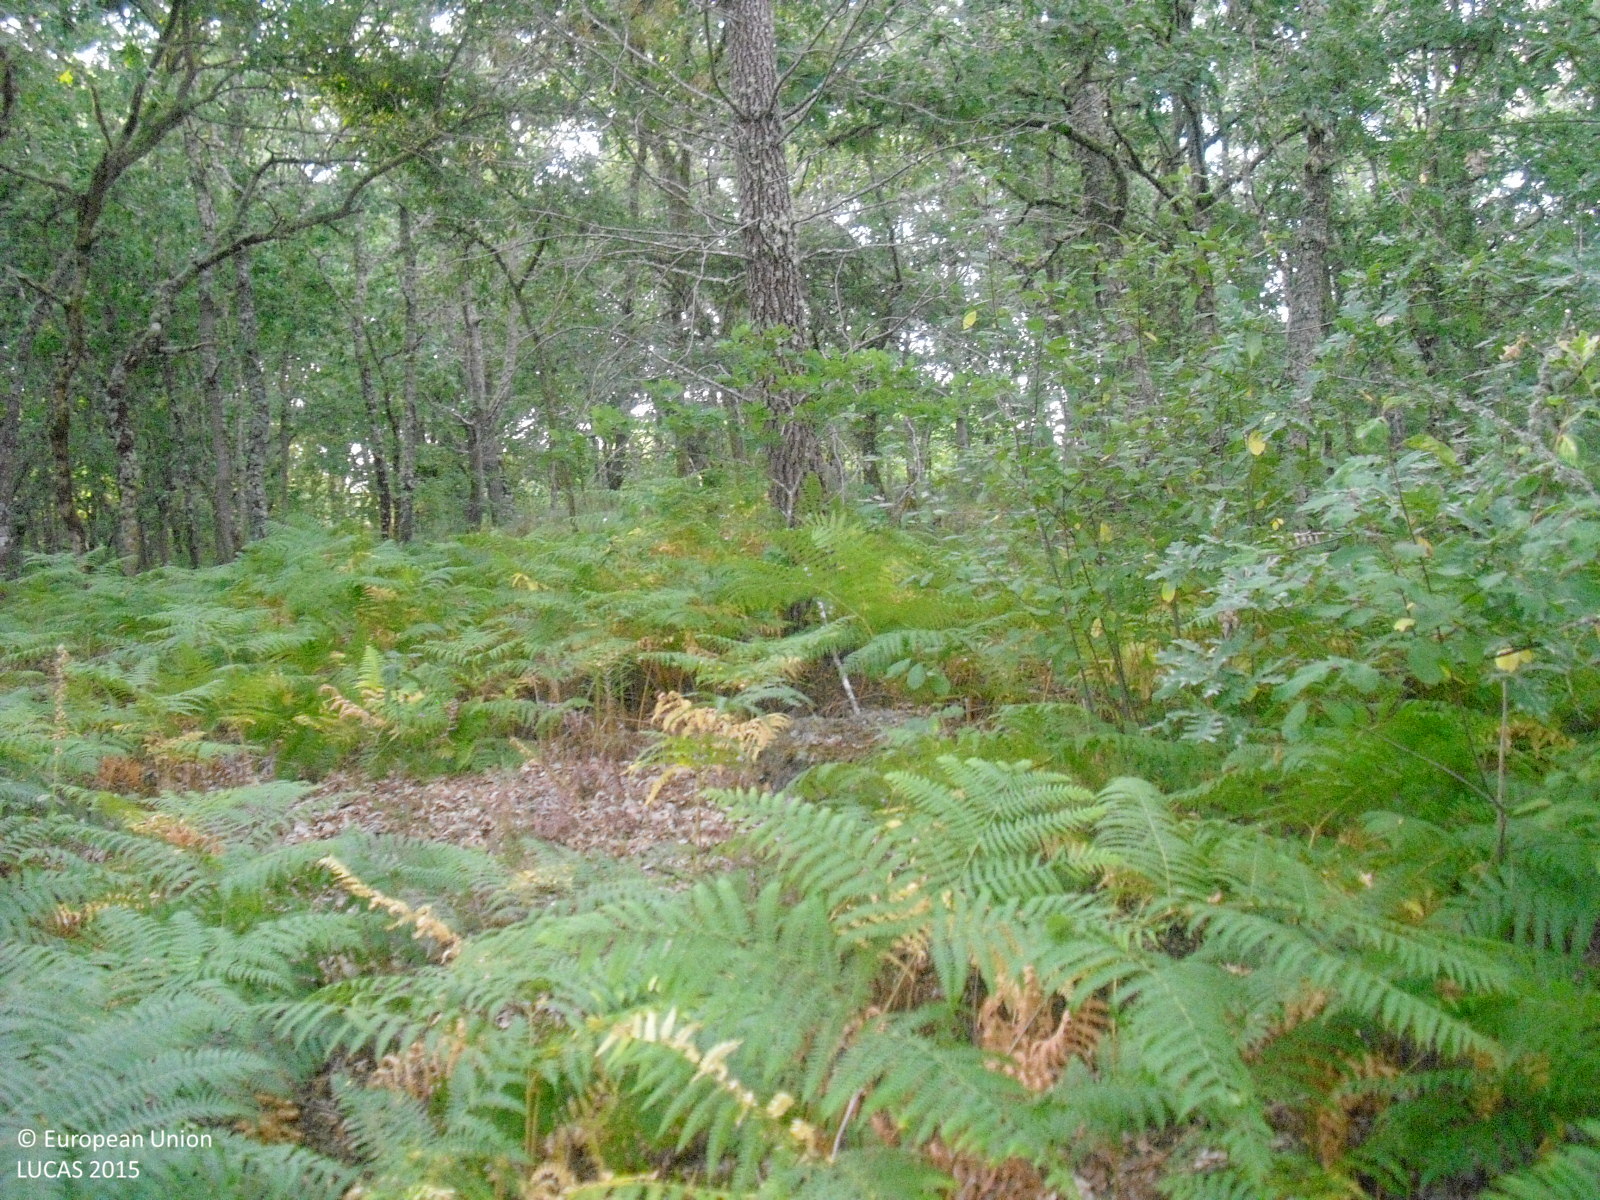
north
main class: Woodland
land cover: Pine dominated mixed woodland
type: hemiboreal forest and nemoral coniferous forest and mixed broadleaved-coniferous forest
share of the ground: > 75 %
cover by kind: broadleaved forest trees 60 %, coniferous forest trees 20 %, shrubs 20 %
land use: Forestry
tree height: > 5 m
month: July
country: ES
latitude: 42.3075
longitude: -7.7488
